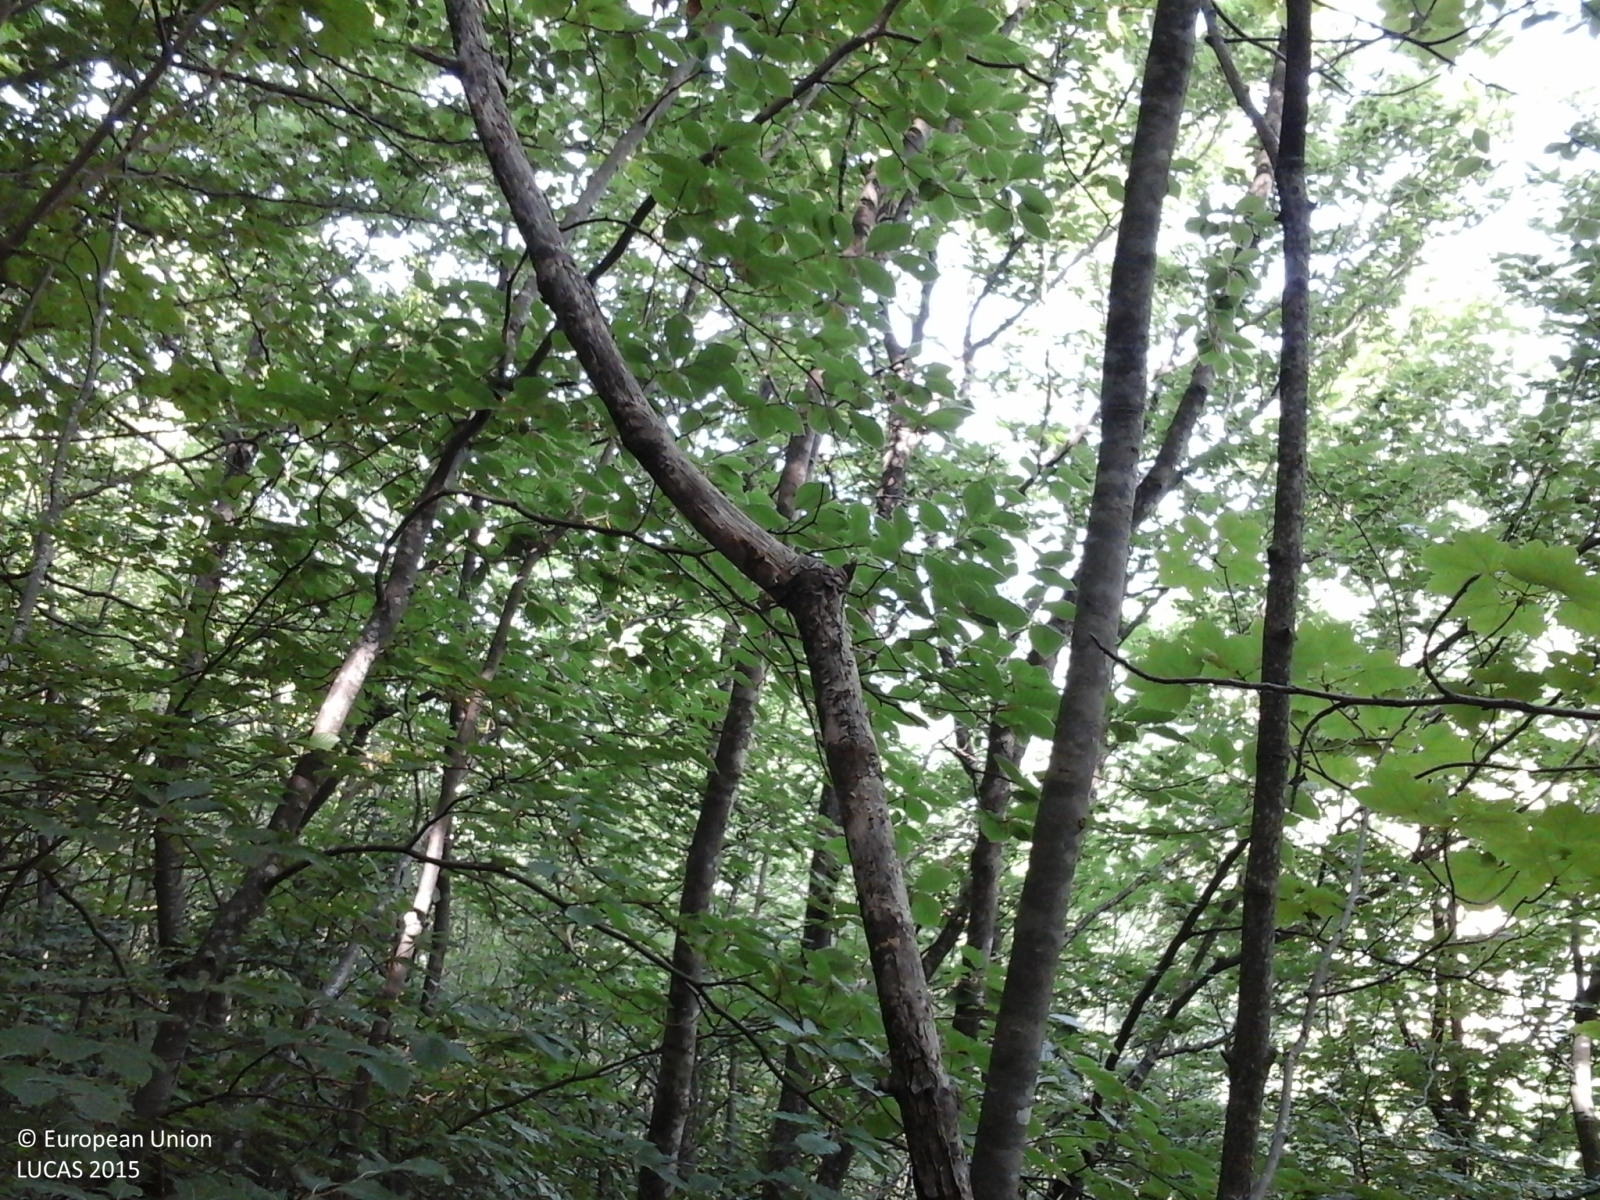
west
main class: Woodland
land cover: Broadleaved woodland
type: mountainous beech forest
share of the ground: > 75 %
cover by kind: broadleaved forest trees 95 %, herbaceous plants 5 %
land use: Forestry
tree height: > 5 m
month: May
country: IT
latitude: 41.7655
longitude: 13.3917
